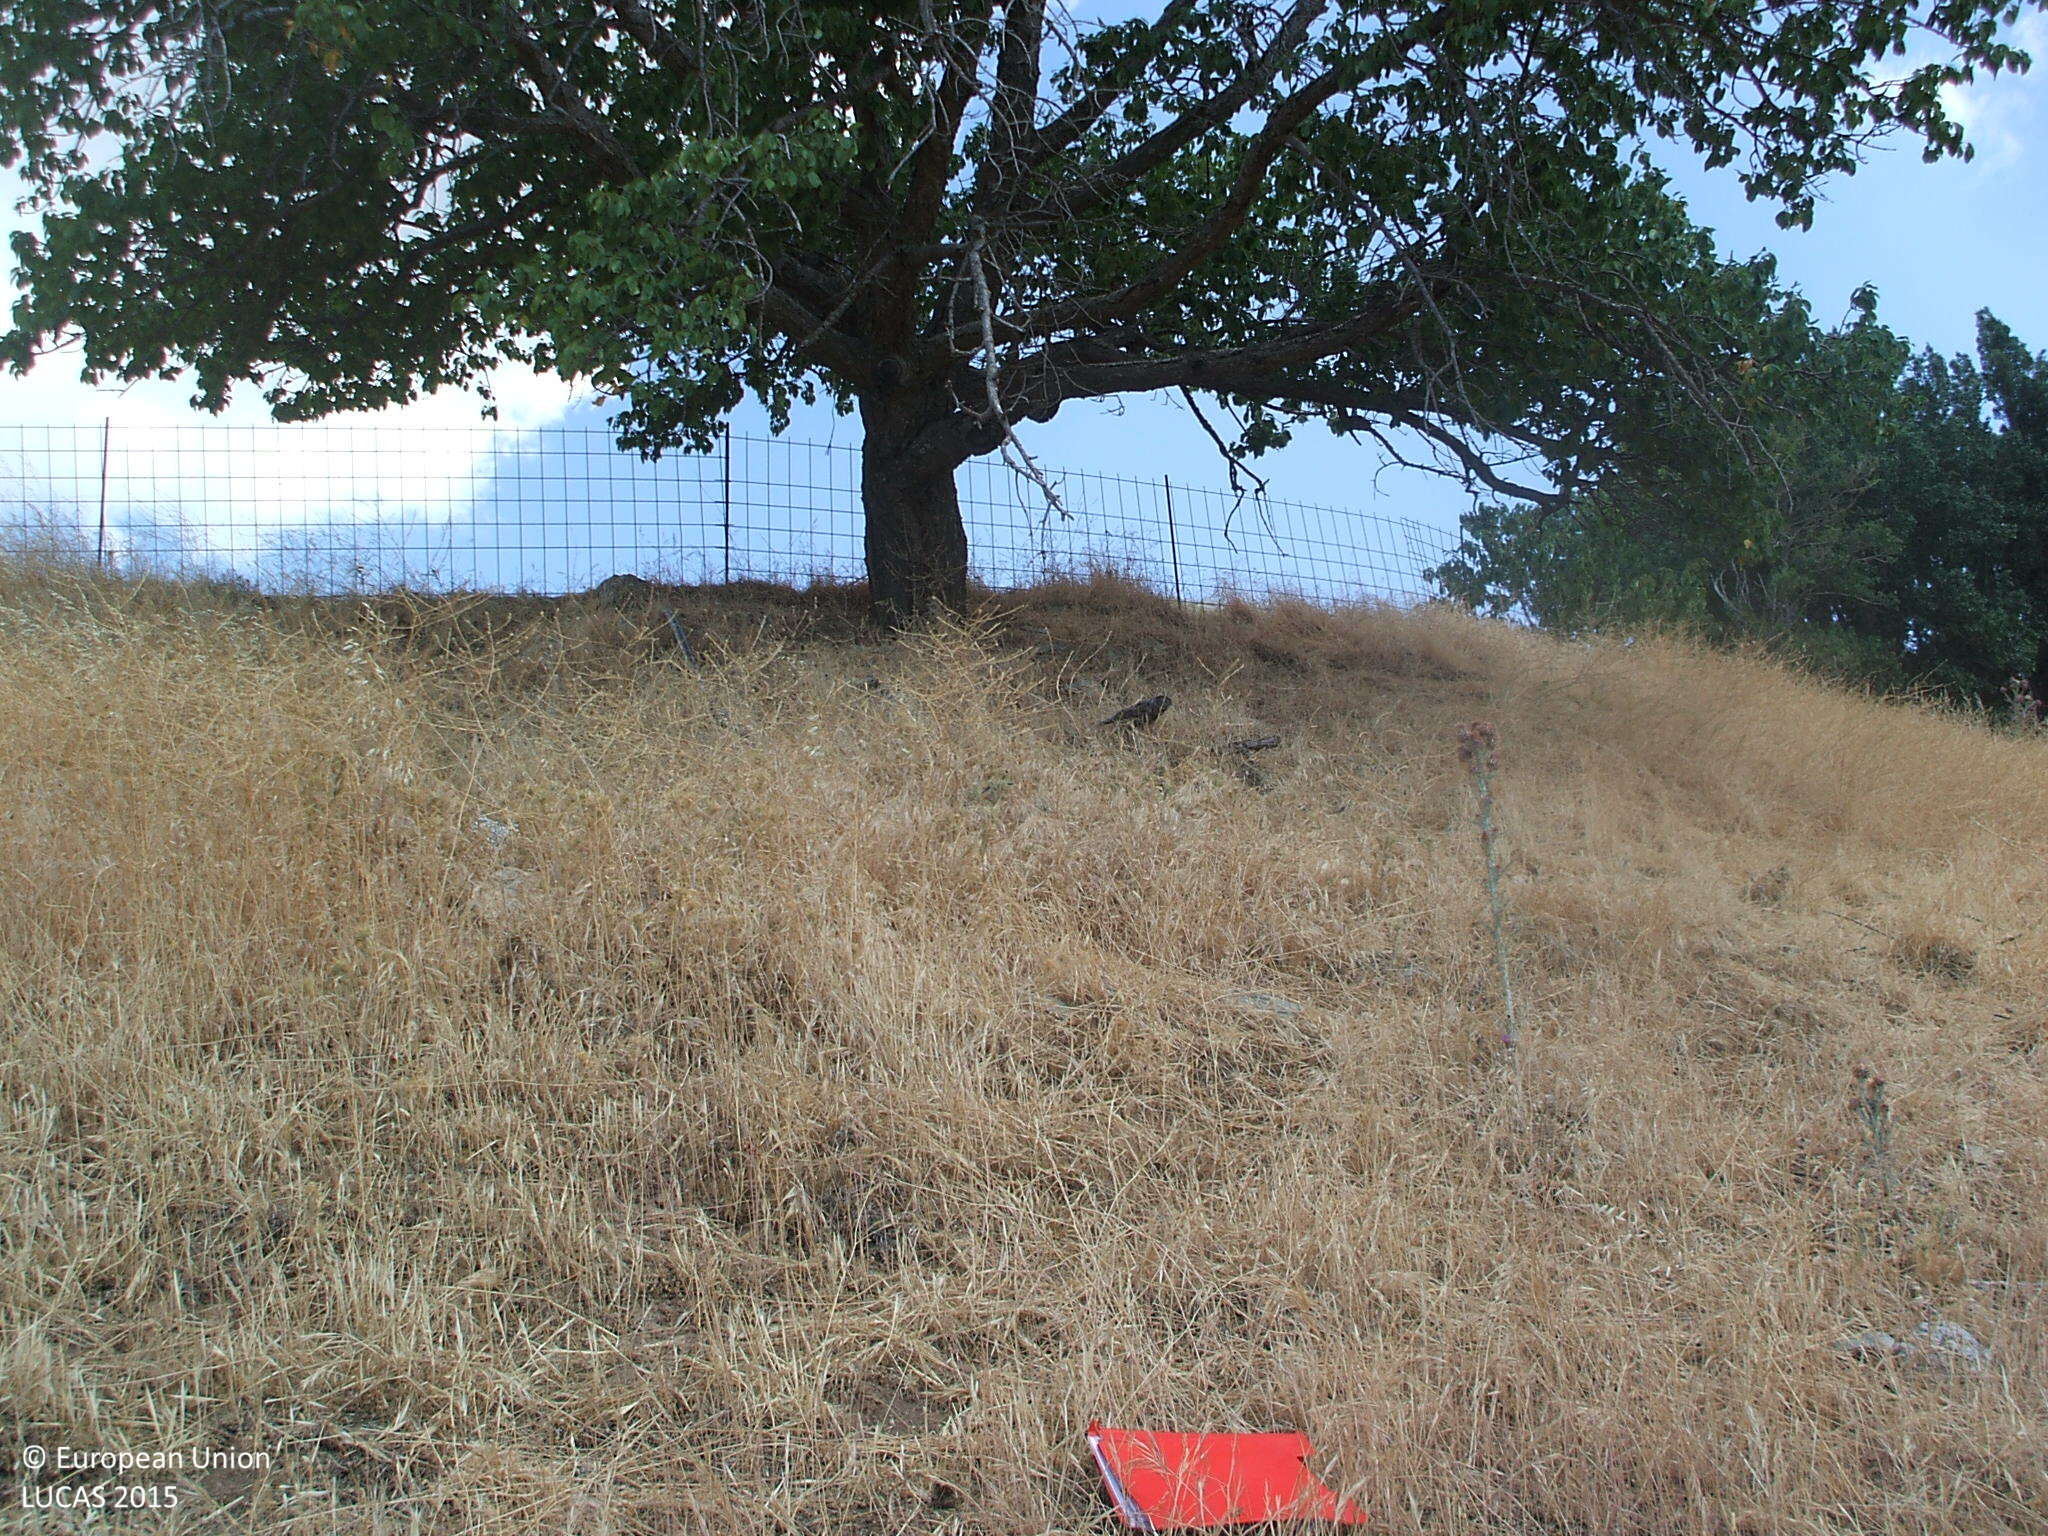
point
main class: Grassland
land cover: Grassland with sparse tree/shrub cover
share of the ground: > 75 %
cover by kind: herbaceous plants 95 %, broadleaved forest trees 5 %
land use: Semi-natural and natural areas not in use
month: July
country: ES
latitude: 37.0692
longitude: -2.8821
